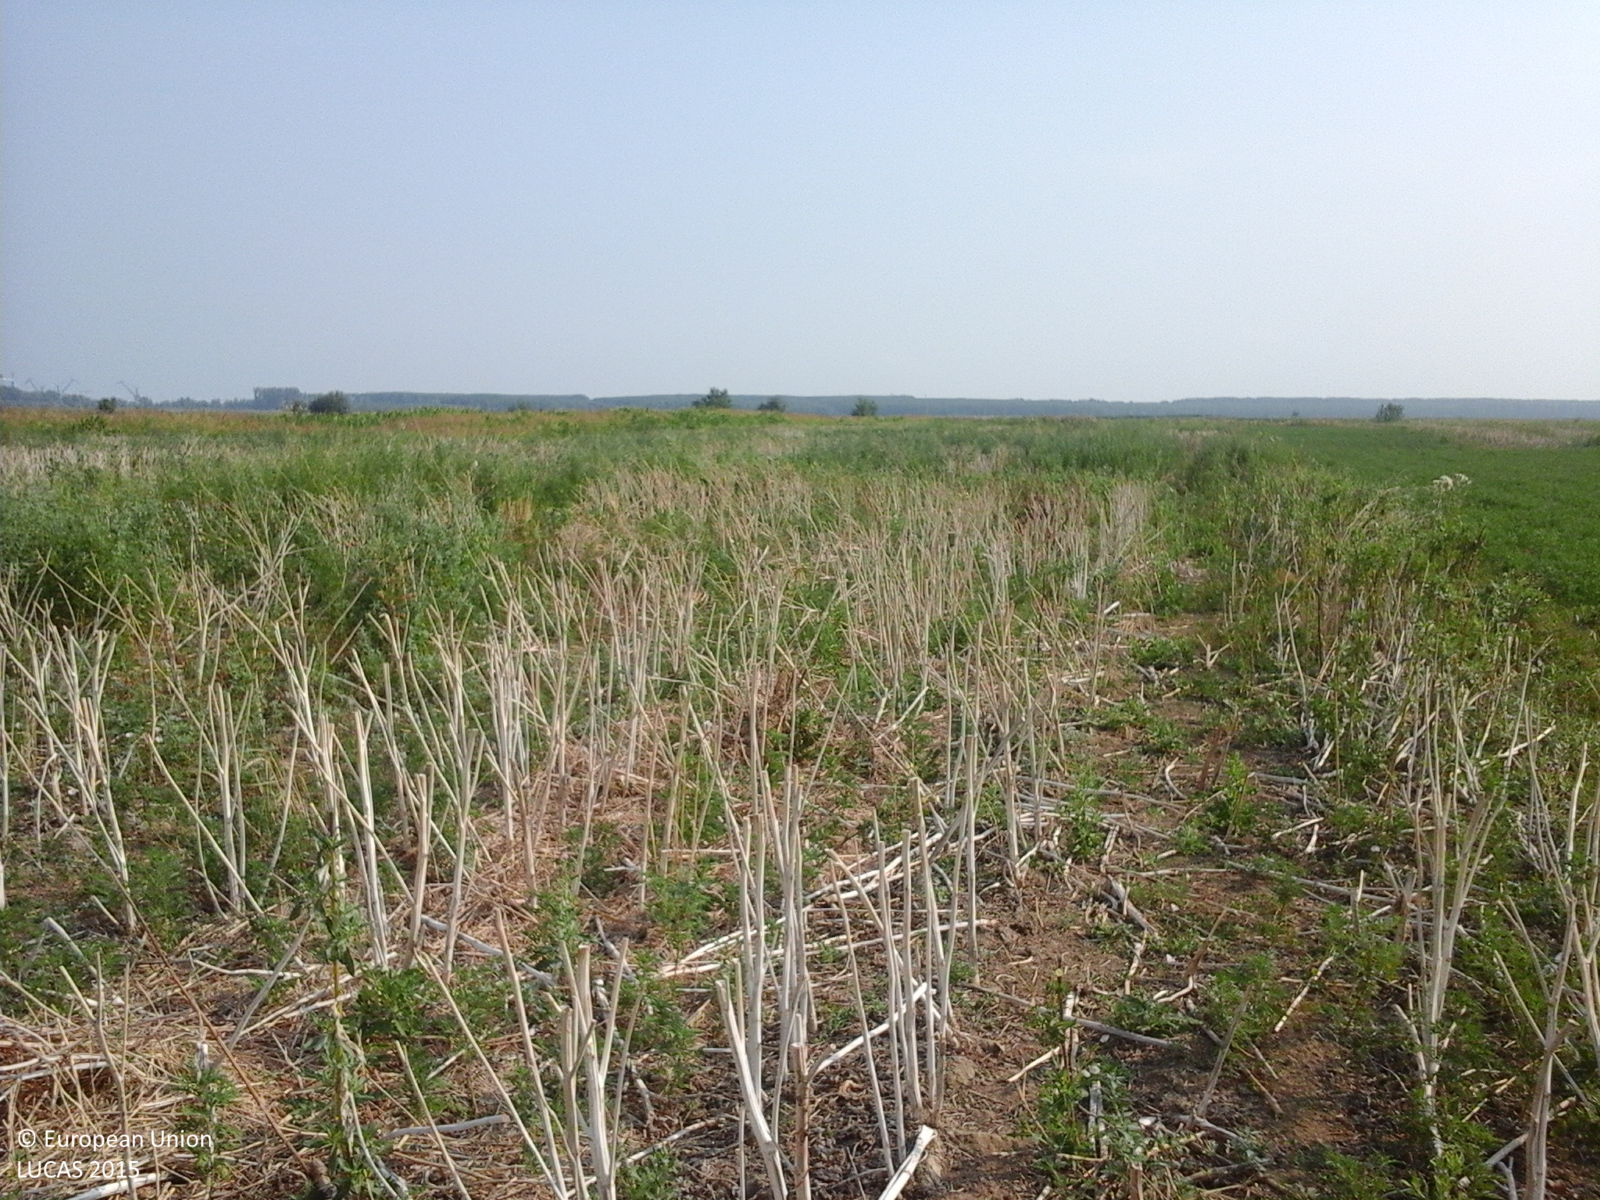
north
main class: Cropland
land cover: Rape and turnip rape
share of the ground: < 10 %
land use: Agriculture (excluding fallow land and kitchen gardens)
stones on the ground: < 10 %
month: July
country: RO
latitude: 45.4173
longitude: 28.1000
